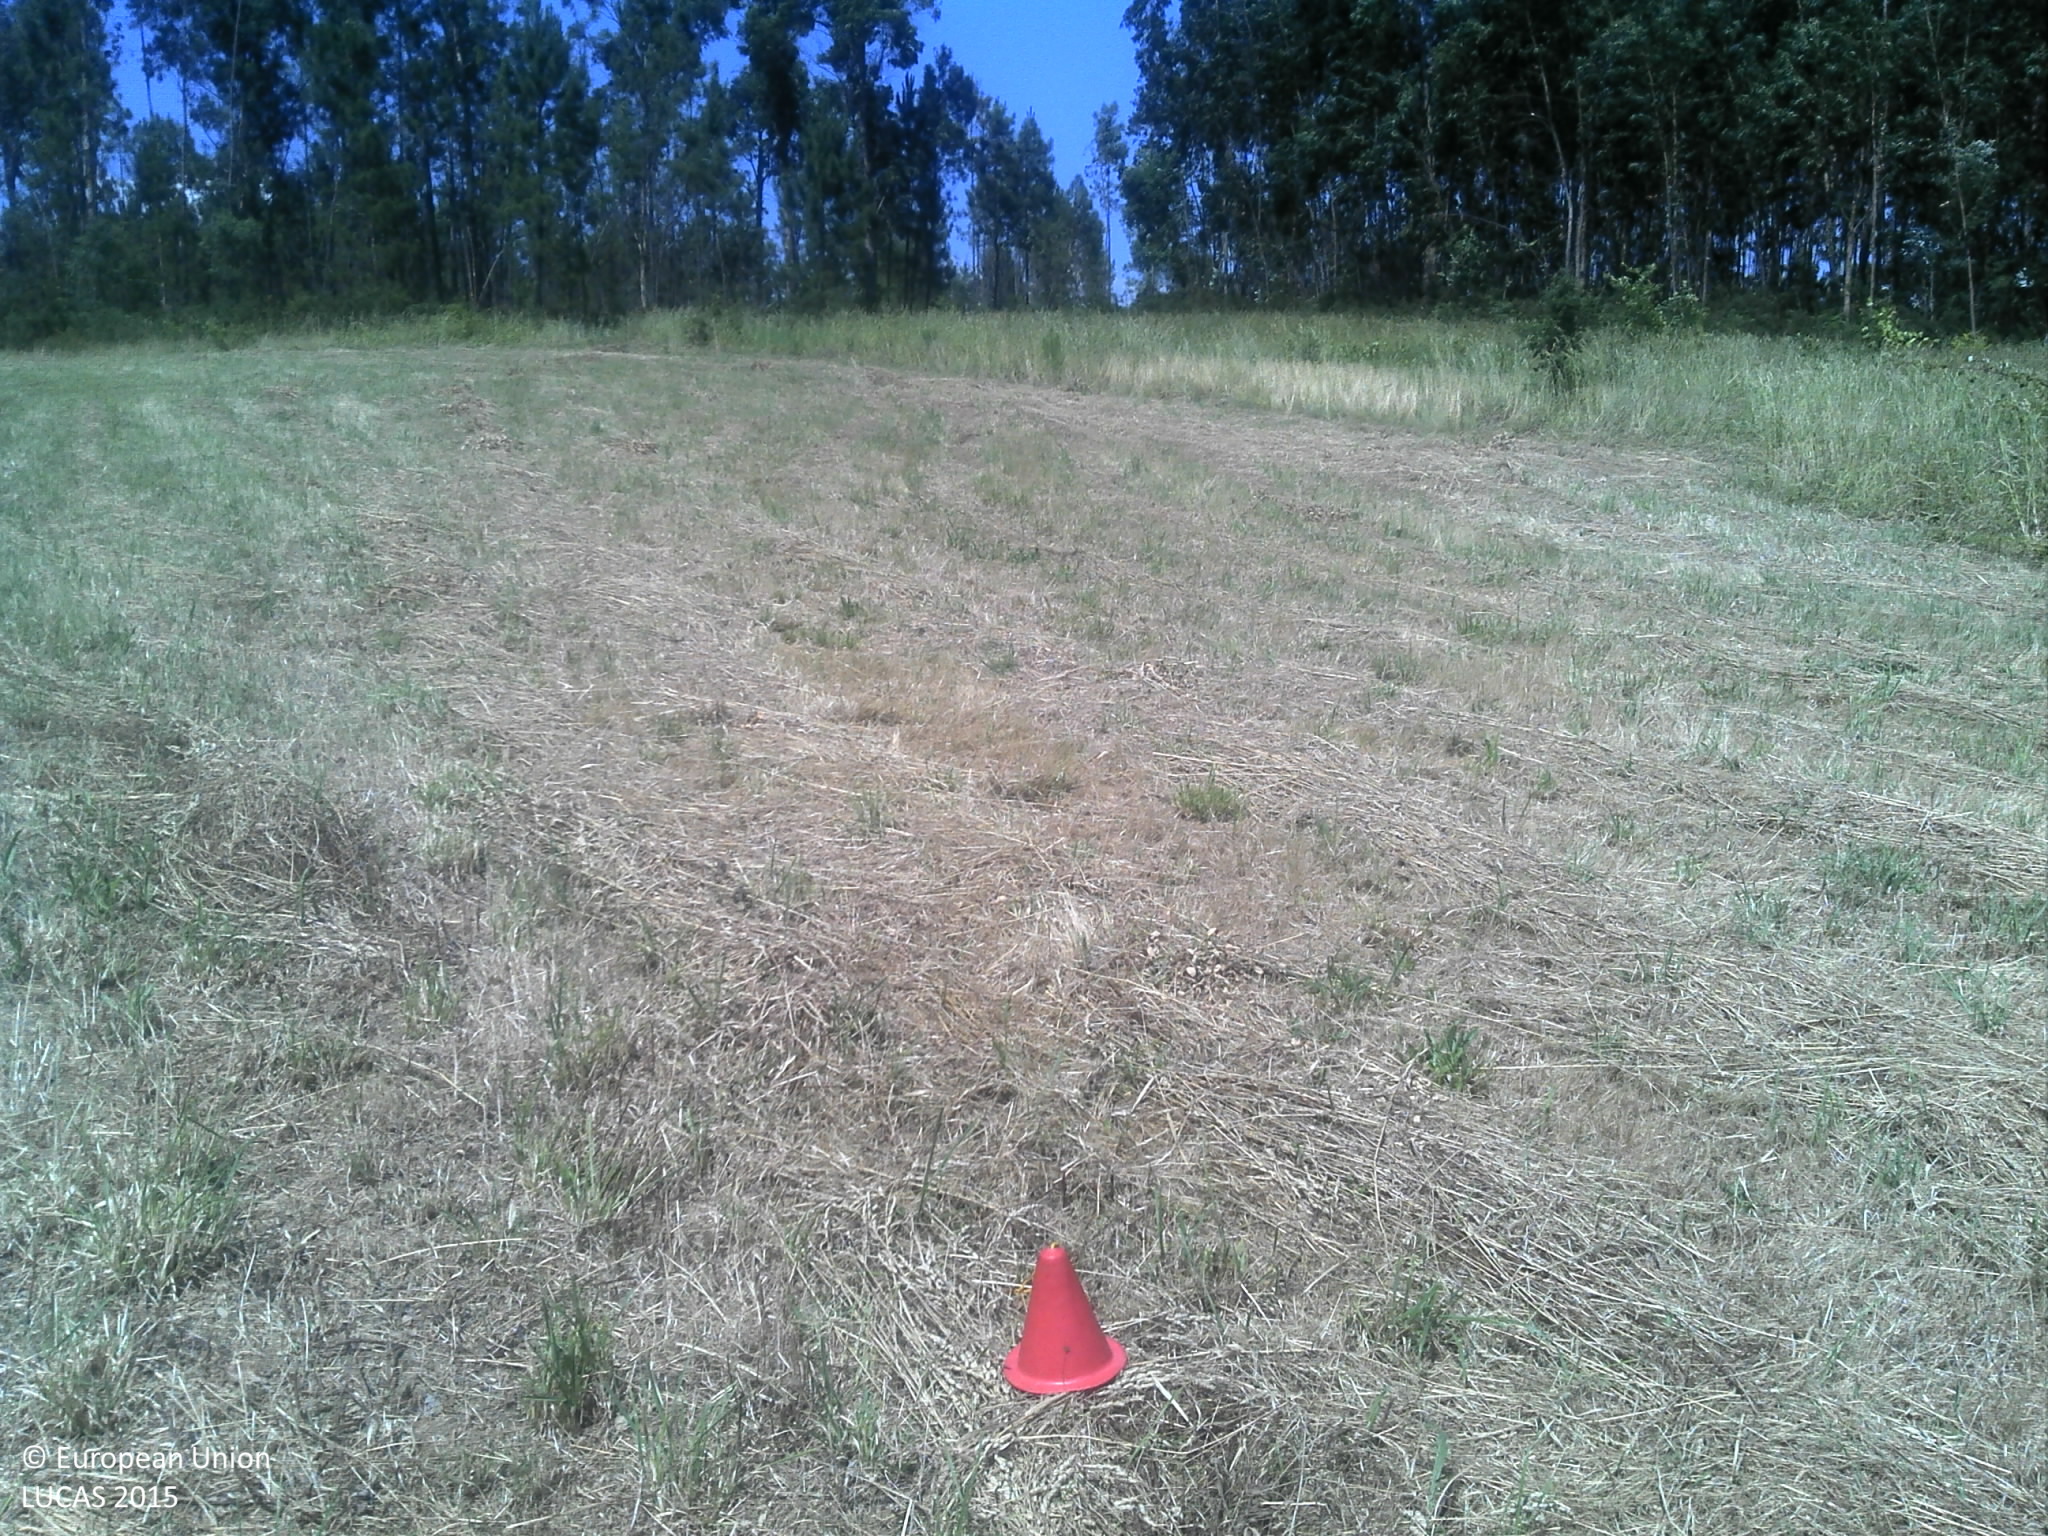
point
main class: Cropland
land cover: Temporary grasslands
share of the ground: > 75 %
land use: Agriculture (excluding fallow land and kitchen gardens)
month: June
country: PT
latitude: 41.5361
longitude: -8.5315
